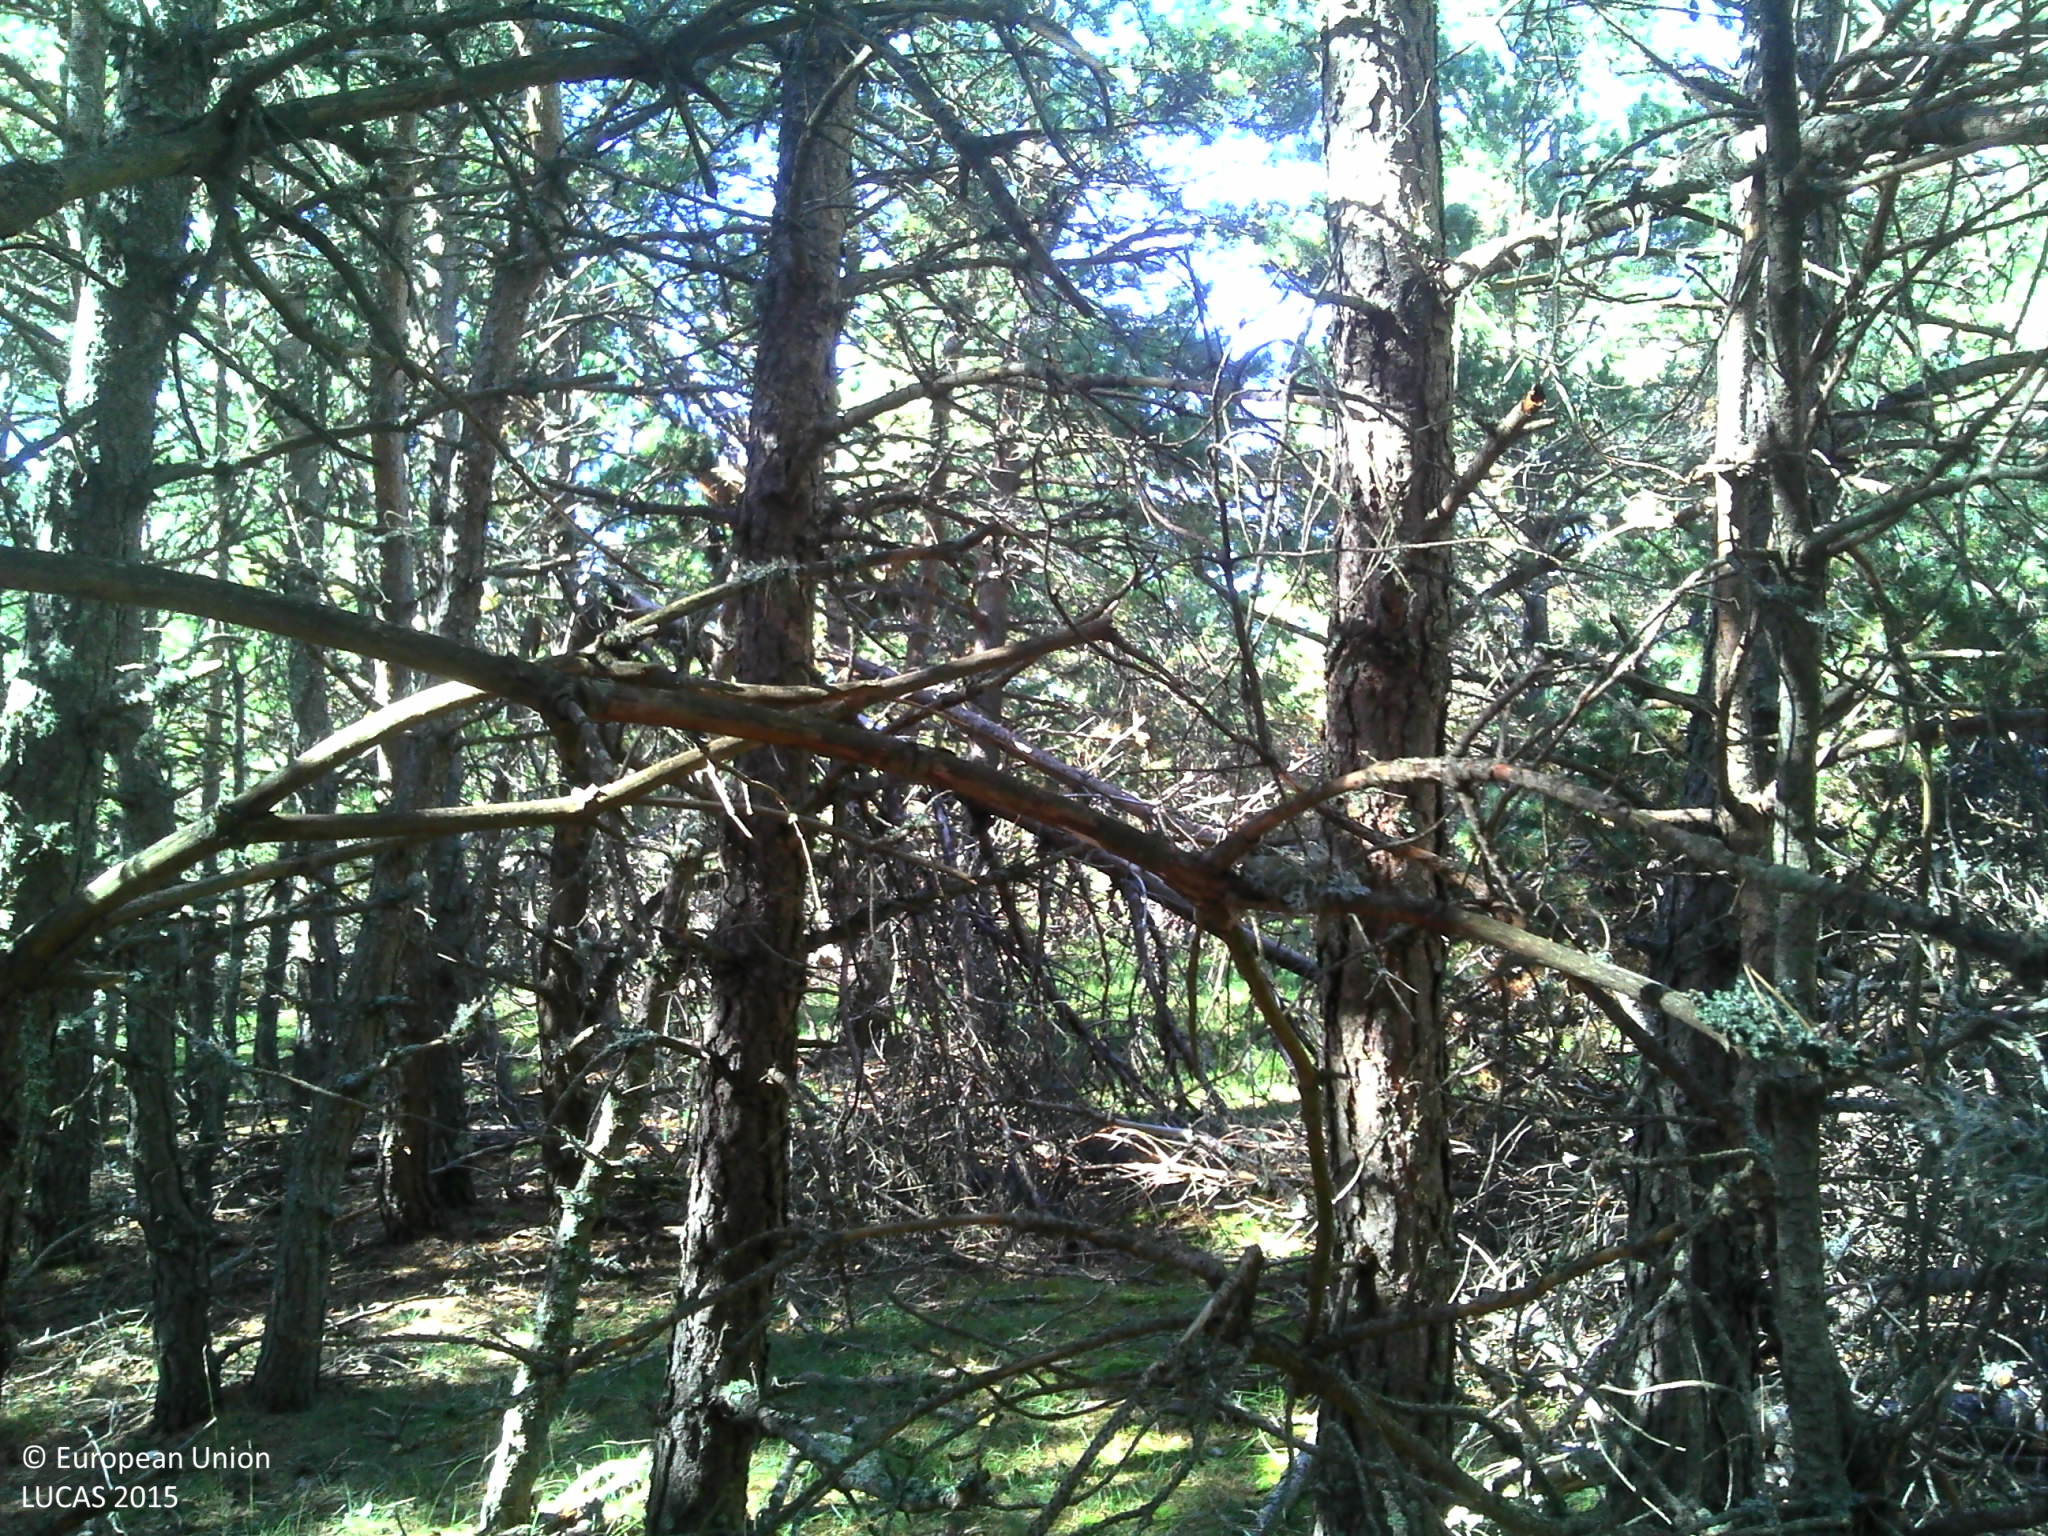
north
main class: Woodland
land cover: Pine dominated coniferous woodland
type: alpine coniferous forest
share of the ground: > 75 %
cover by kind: coniferous forest trees 80 %, herbaceous plants 15 %, broadleaved forest trees 5 %
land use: Forestry
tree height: > 5 m
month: June
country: FR
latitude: 44.1645
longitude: 5.5434
